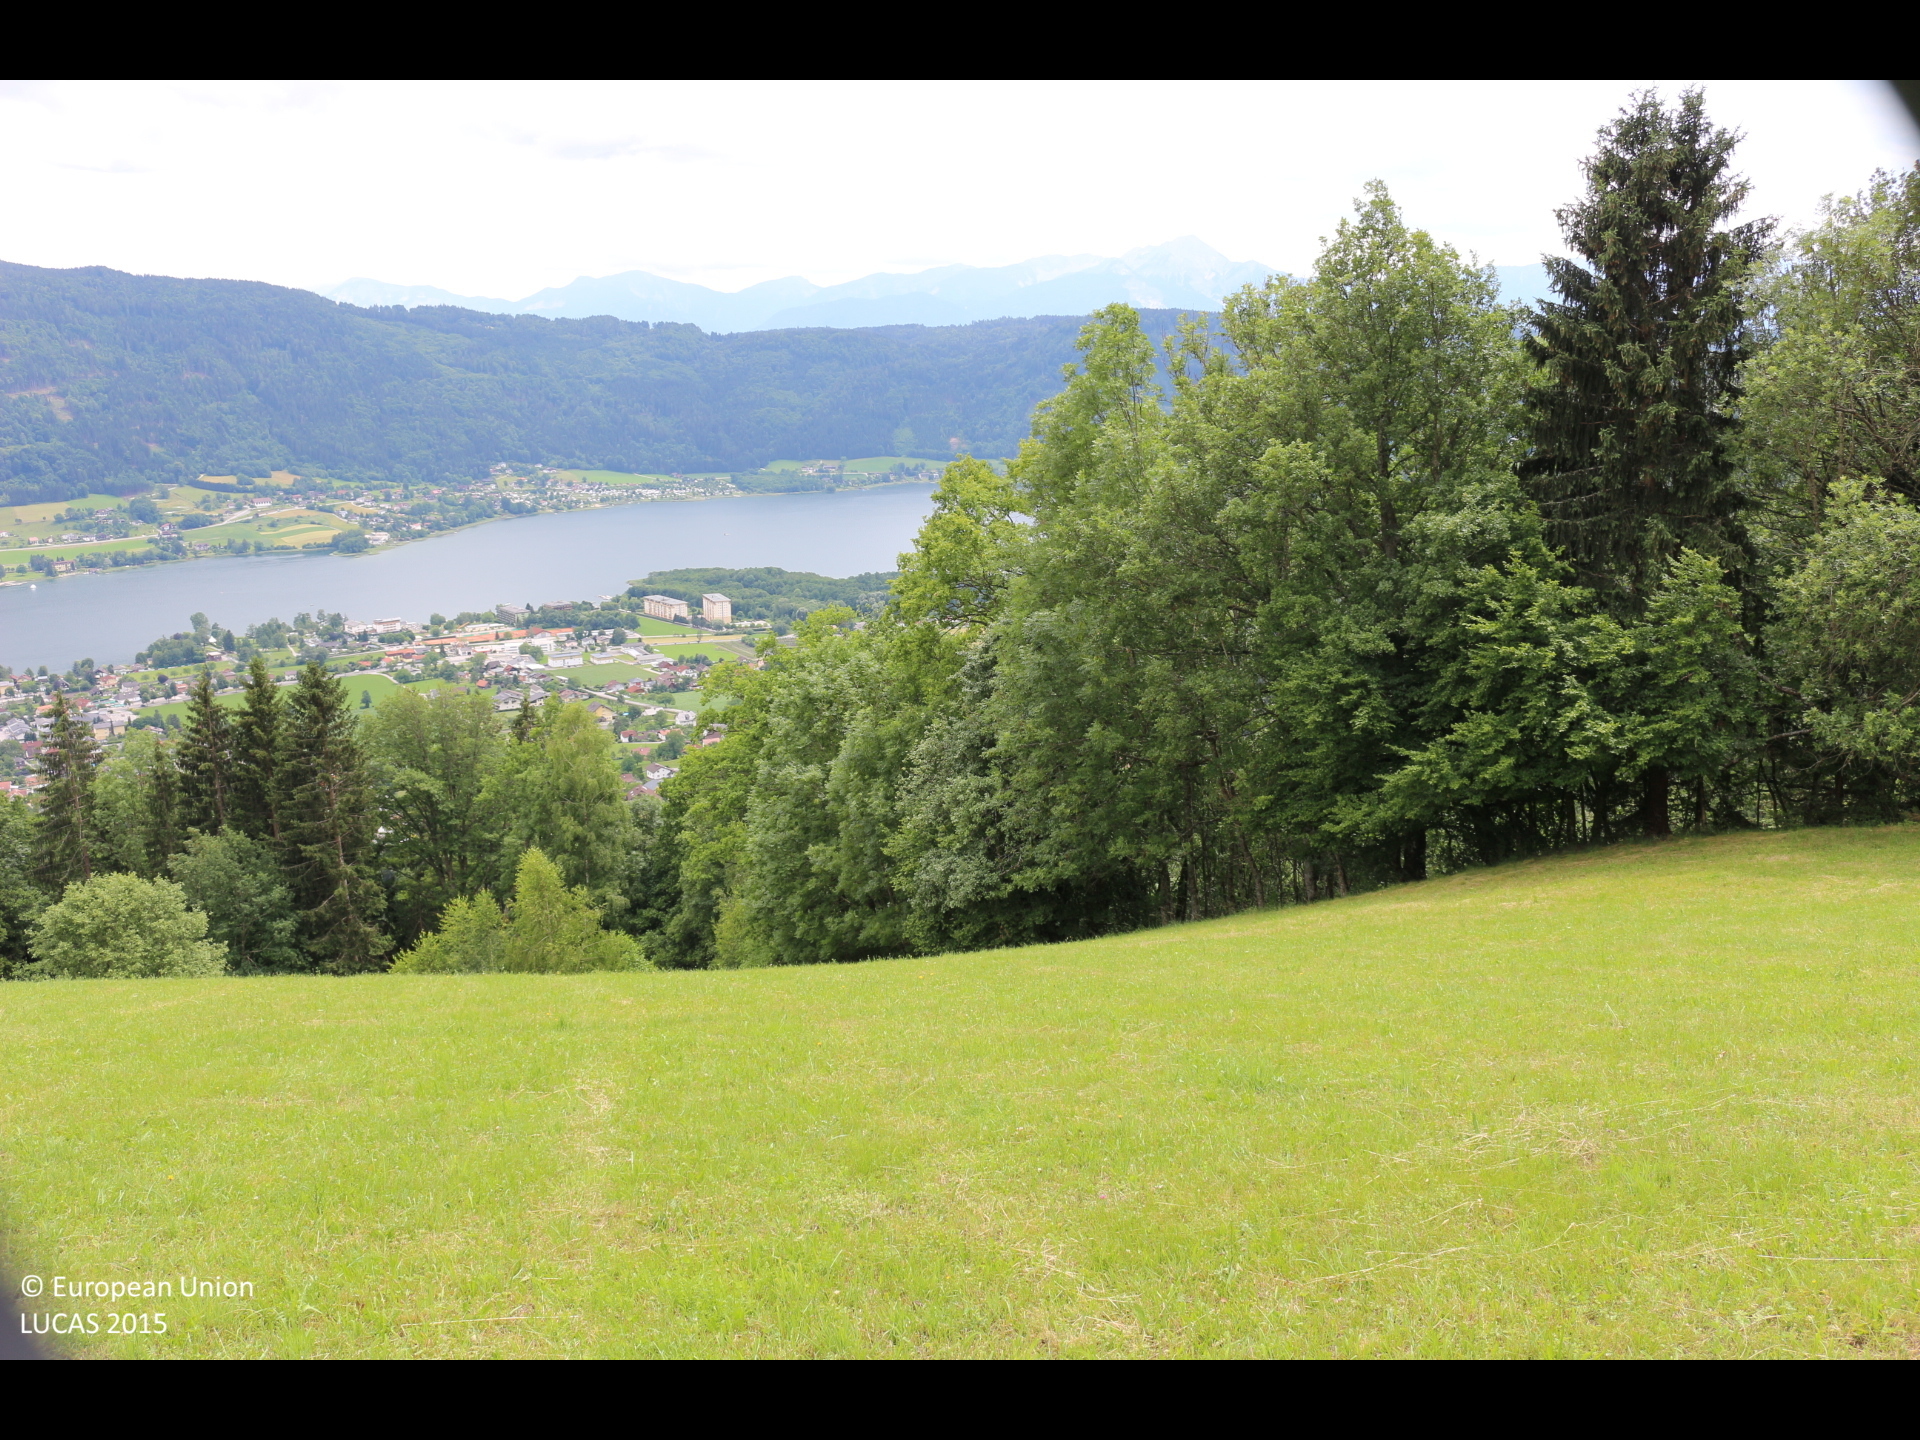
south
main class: Grassland
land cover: Grassland without tree/shrub cover
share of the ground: > 75 %
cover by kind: herbaceous plants 100 %
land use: Agriculture (excluding fallow land and kitchen gardens)
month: June
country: AT
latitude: 46.6927
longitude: 13.9596
